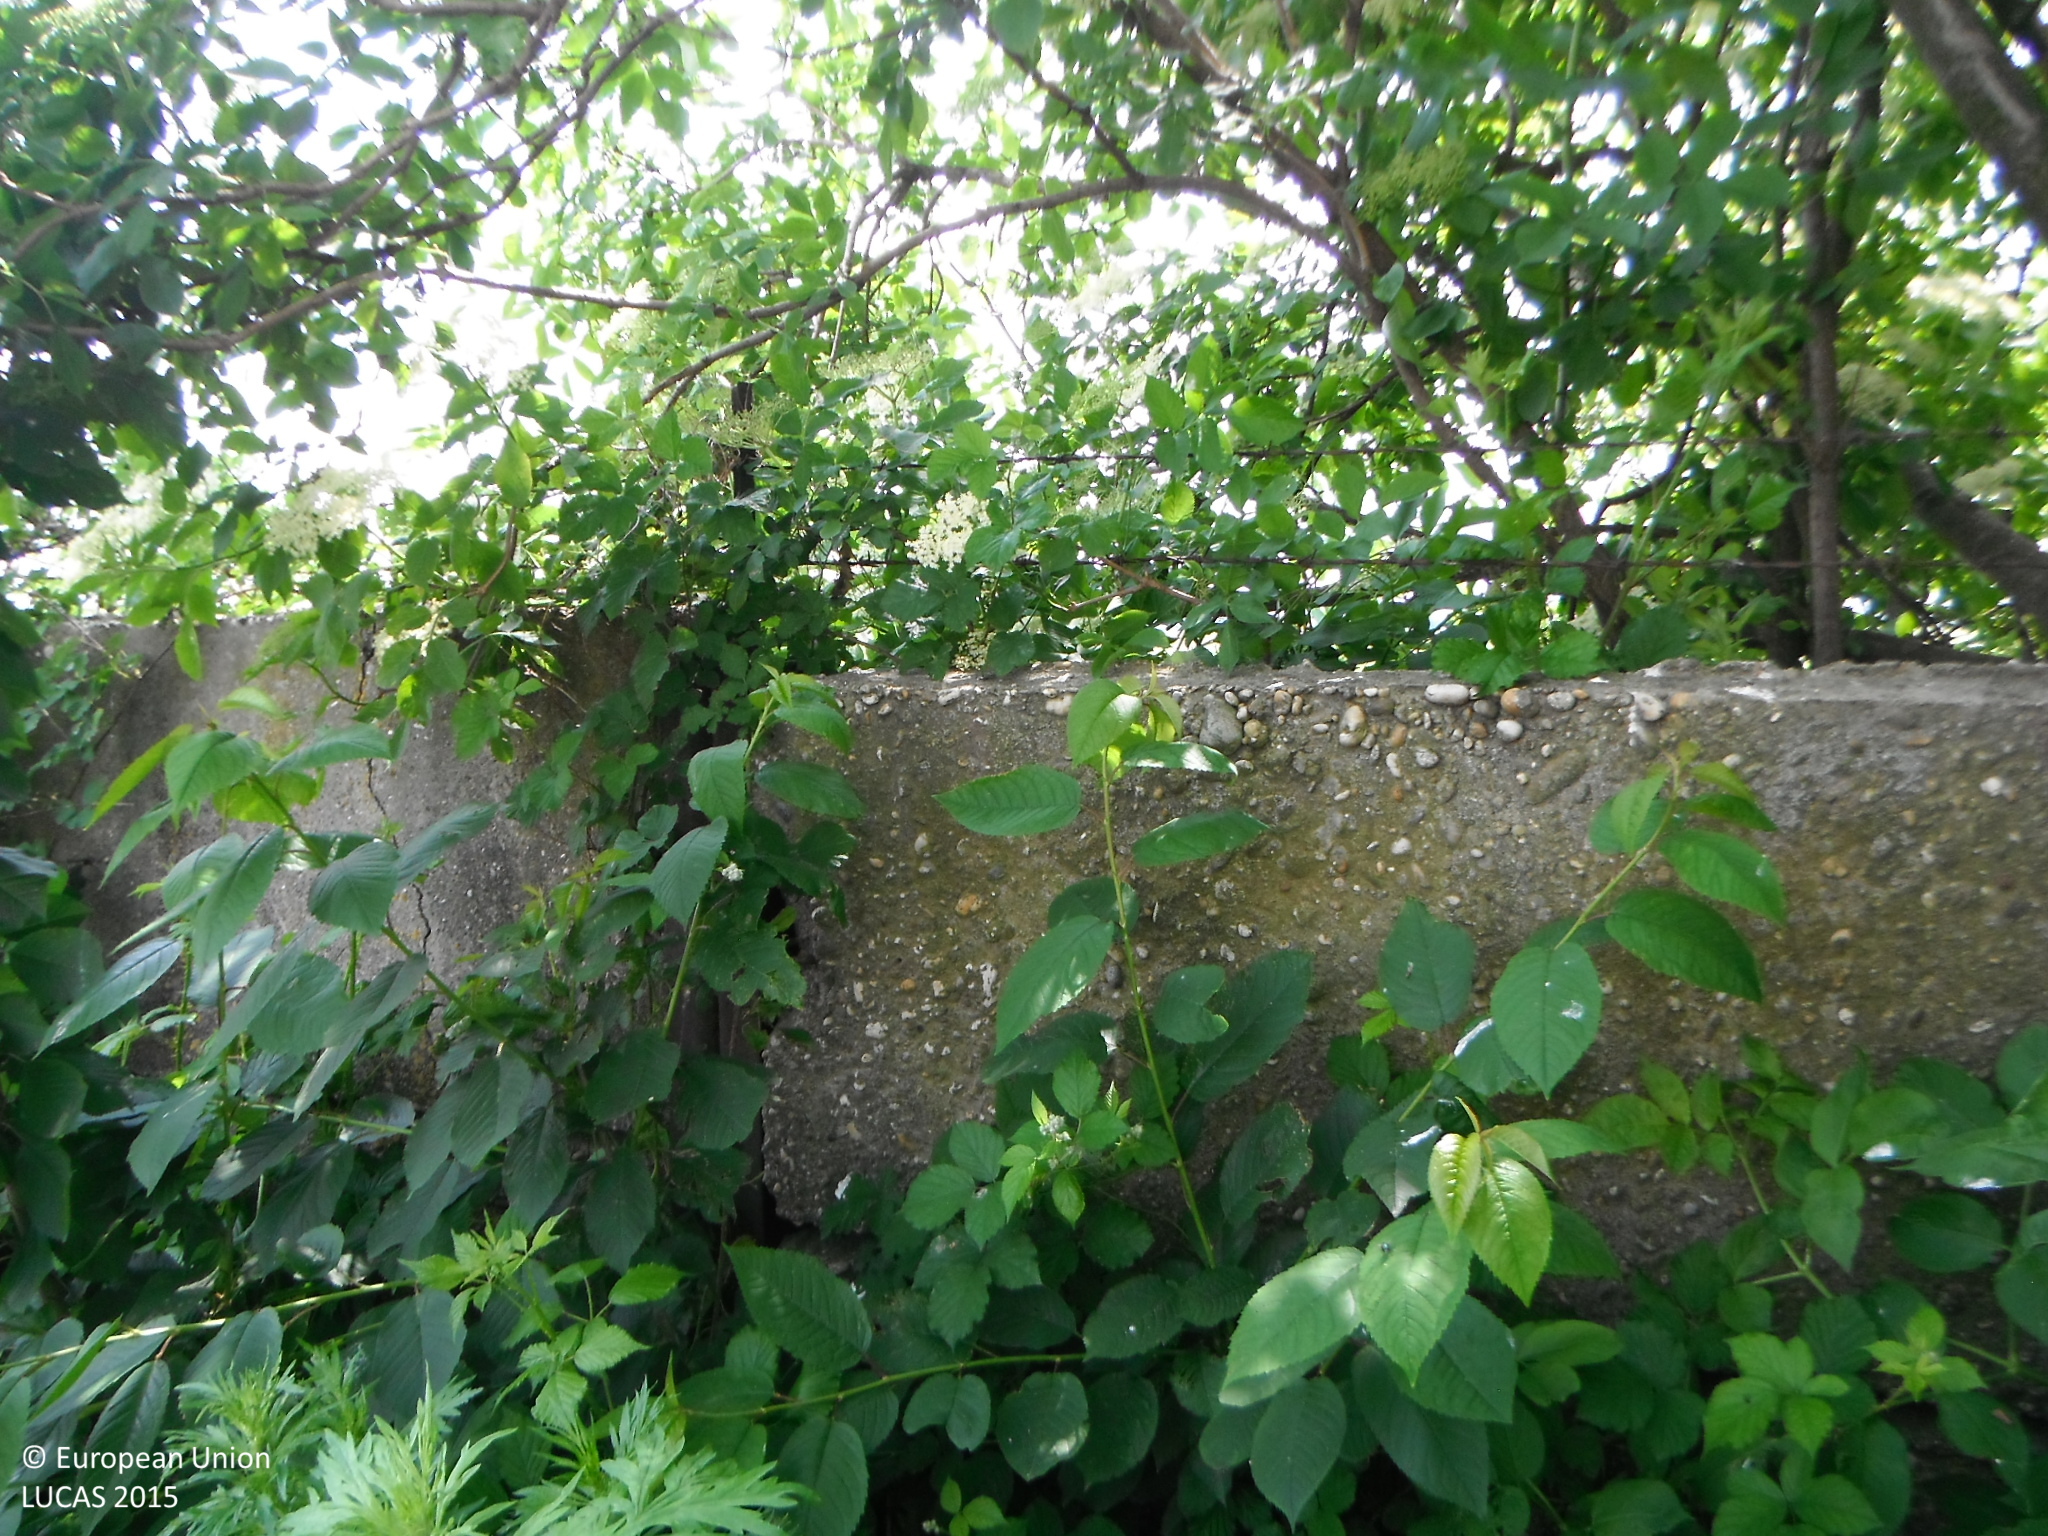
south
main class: Woodland
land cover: Broadleaved woodland
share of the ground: > 75 %
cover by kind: broadleaved forest trees 90 %, shrubs 5 %, herbaceous plants 5 %
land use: Abandoned areas
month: June
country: SK
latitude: 48.4086
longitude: 18.4053
